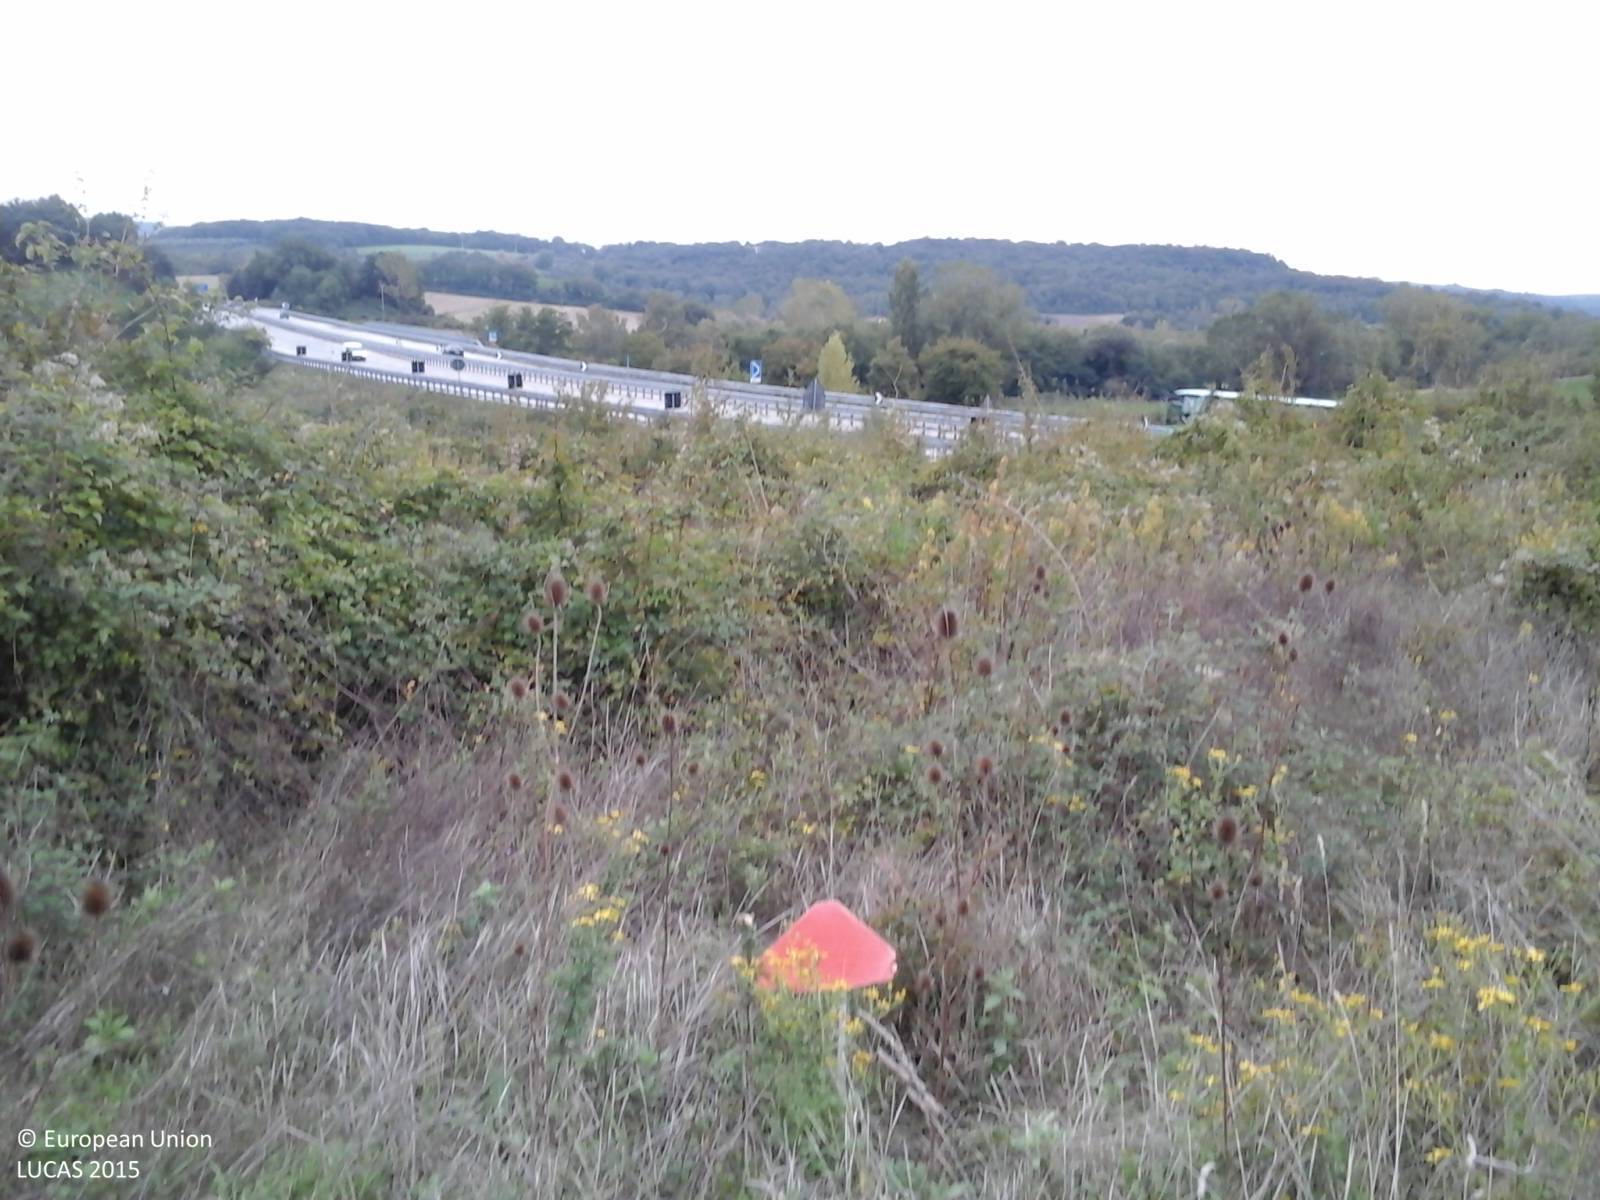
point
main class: Shrubland
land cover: Shrubland without tree cover
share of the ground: > 75 %
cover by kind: shrubs 90 %, herbaceous plants 10 %
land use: Abandoned areas
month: October
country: IT
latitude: 43.3098
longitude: 11.5859
